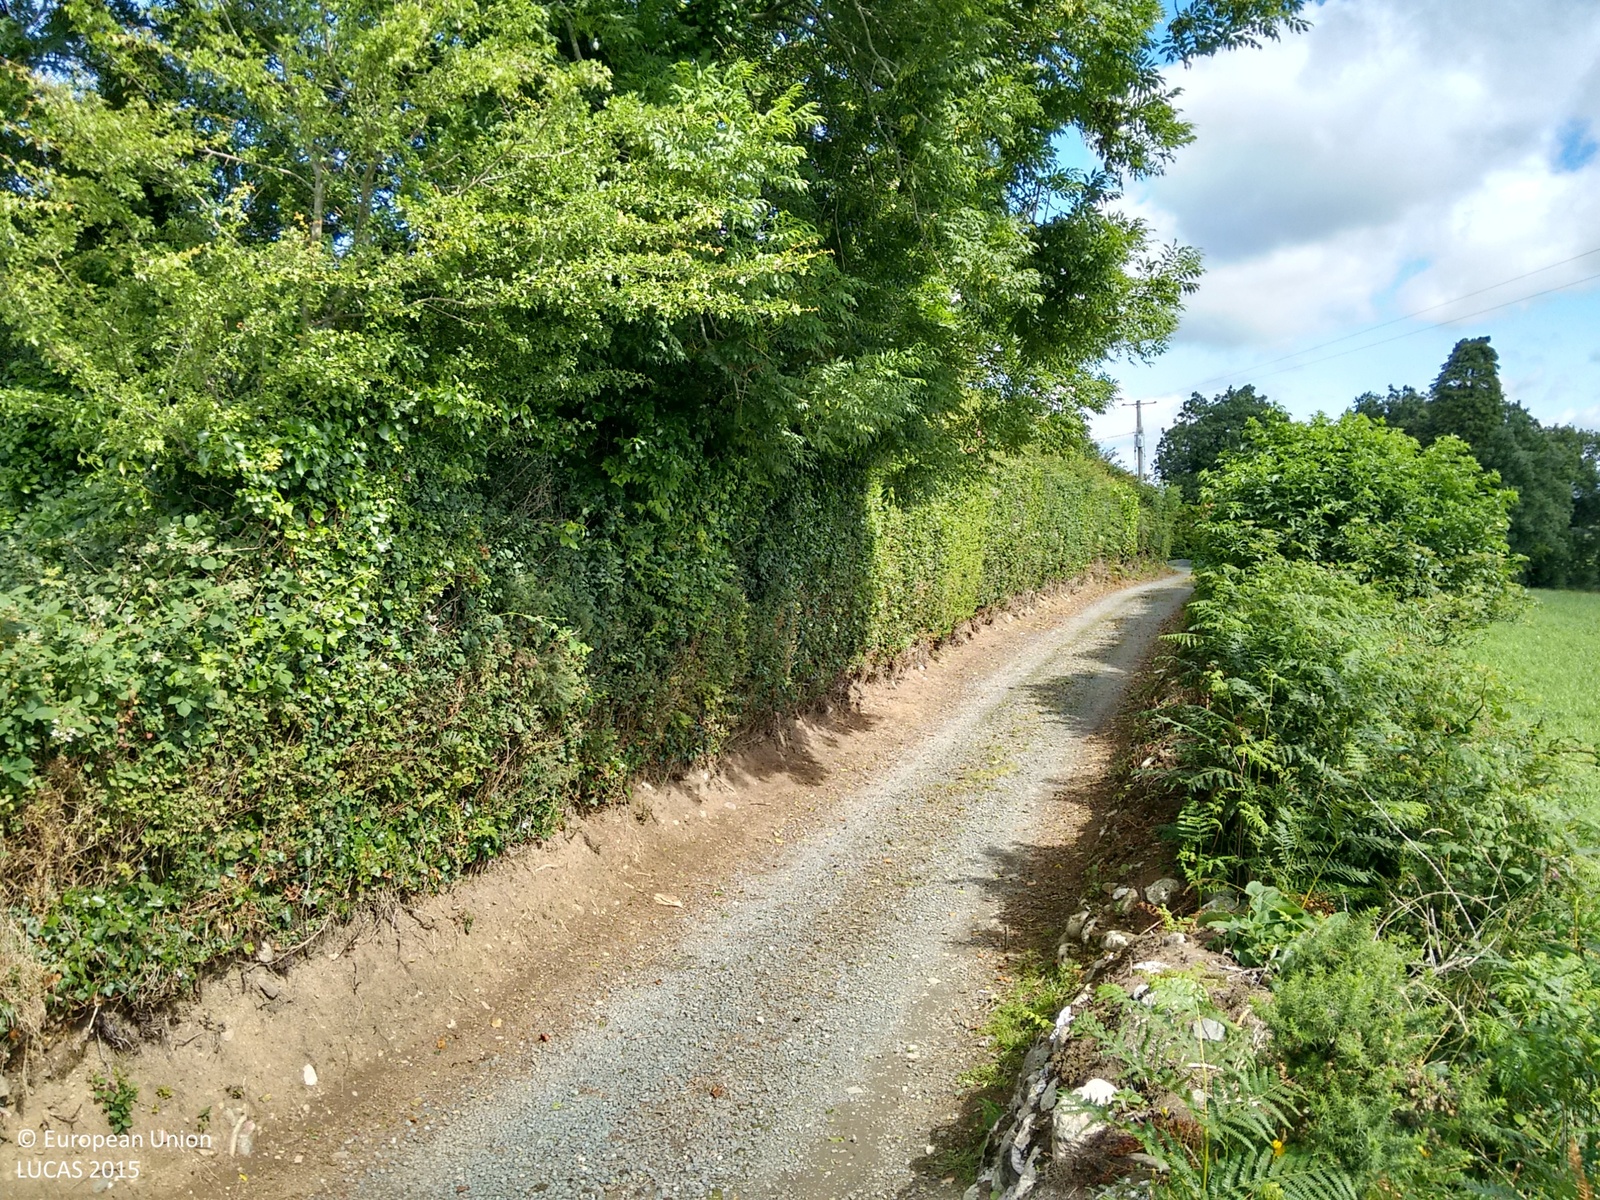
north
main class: Grassland
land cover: Grassland without tree/shrub cover
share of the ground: > 75 %
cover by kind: herbaceous plants 100 %
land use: Agriculture (excluding fallow land and kitchen gardens)
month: July
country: IE
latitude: 52.8646
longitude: -6.2366
